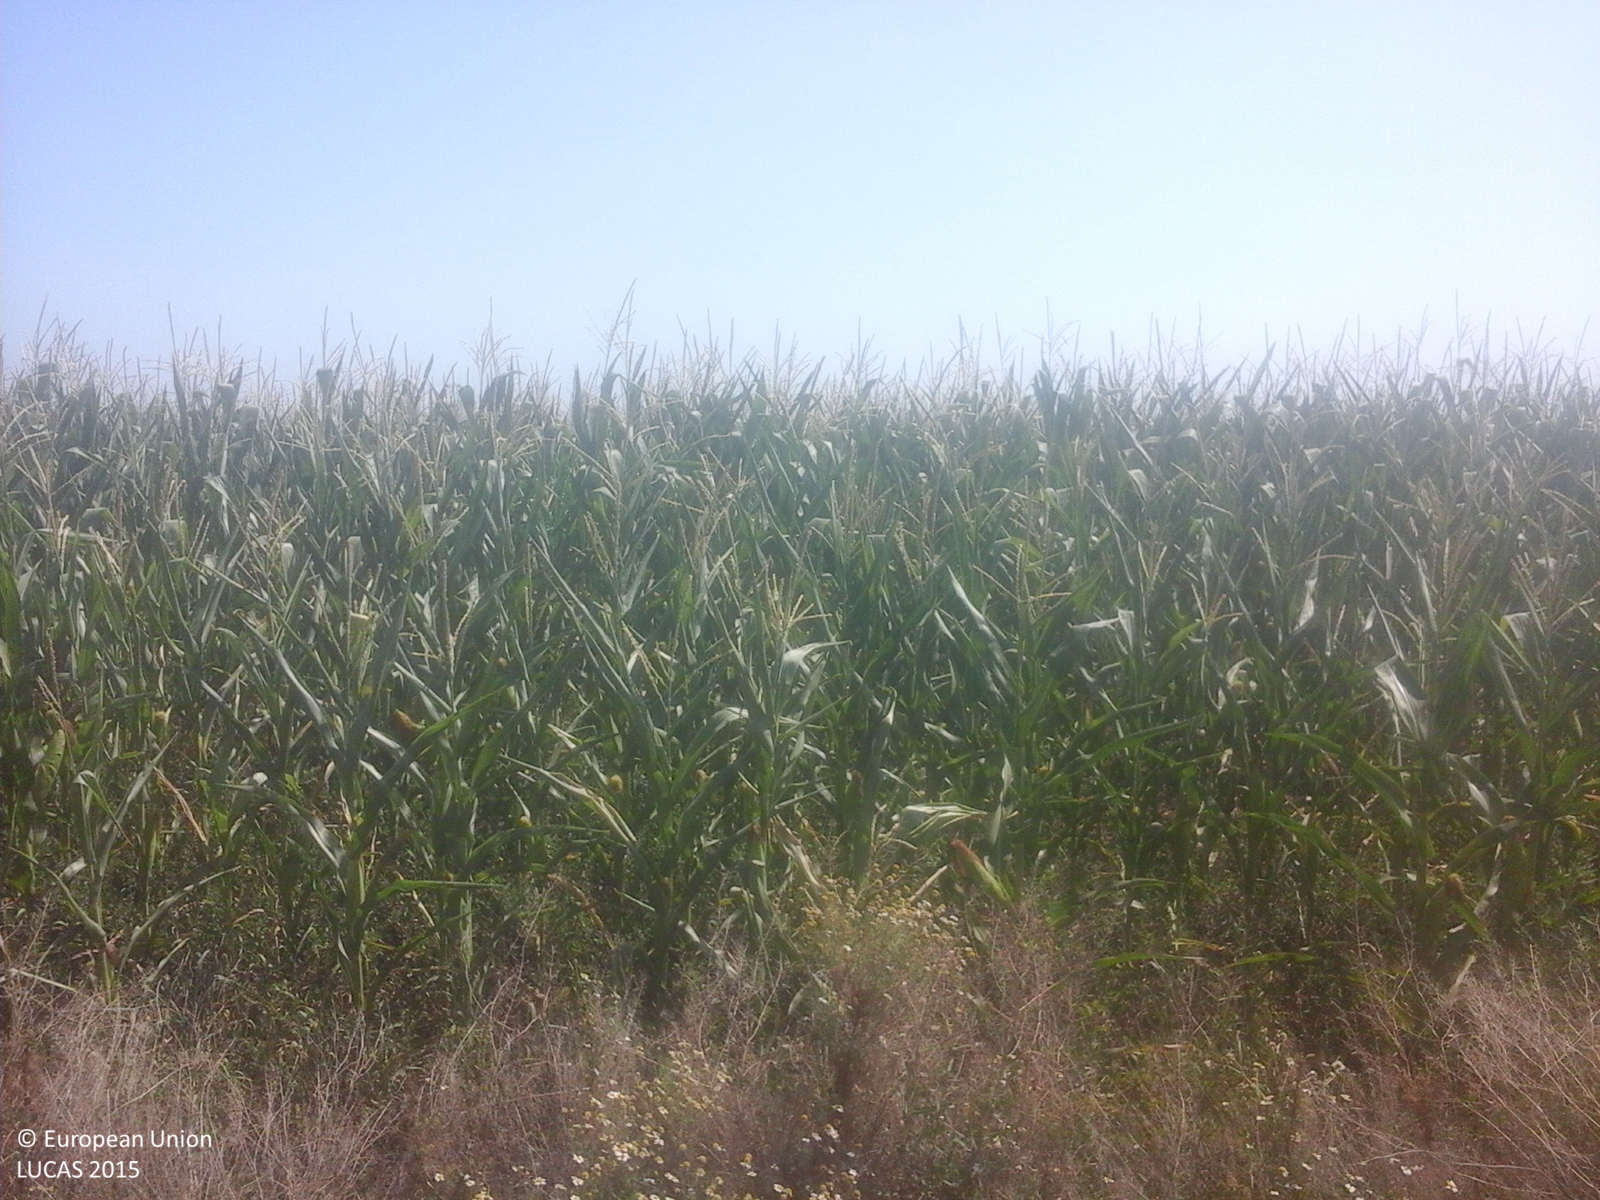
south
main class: Cropland
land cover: Maize
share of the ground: > 75 %
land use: Agriculture (excluding fallow land and kitchen gardens)
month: July
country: RO
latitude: 44.2172
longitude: 26.7024
